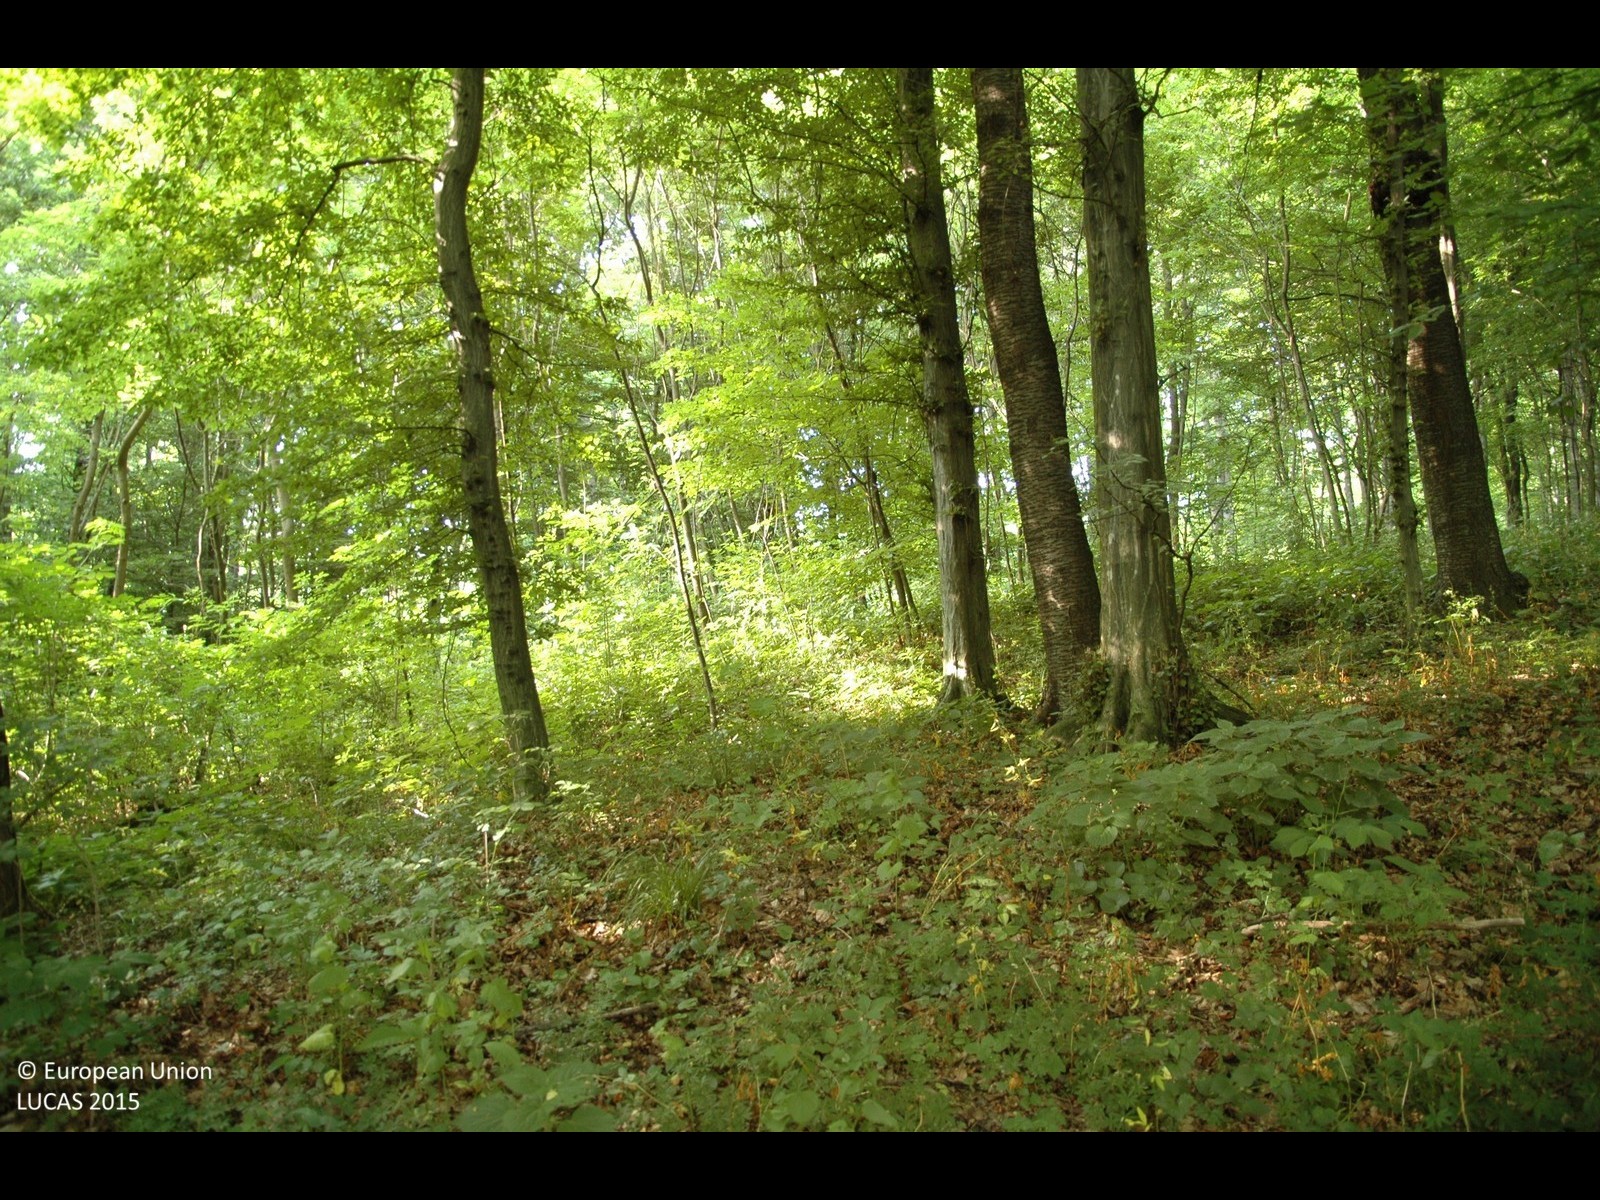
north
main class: Woodland
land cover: Broadleaved woodland
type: beech forest
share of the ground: > 75 %
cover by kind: broadleaved forest trees 100 %
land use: Forestry
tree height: > 5 m
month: June
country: HR
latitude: 46.4879
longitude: 16.3450
